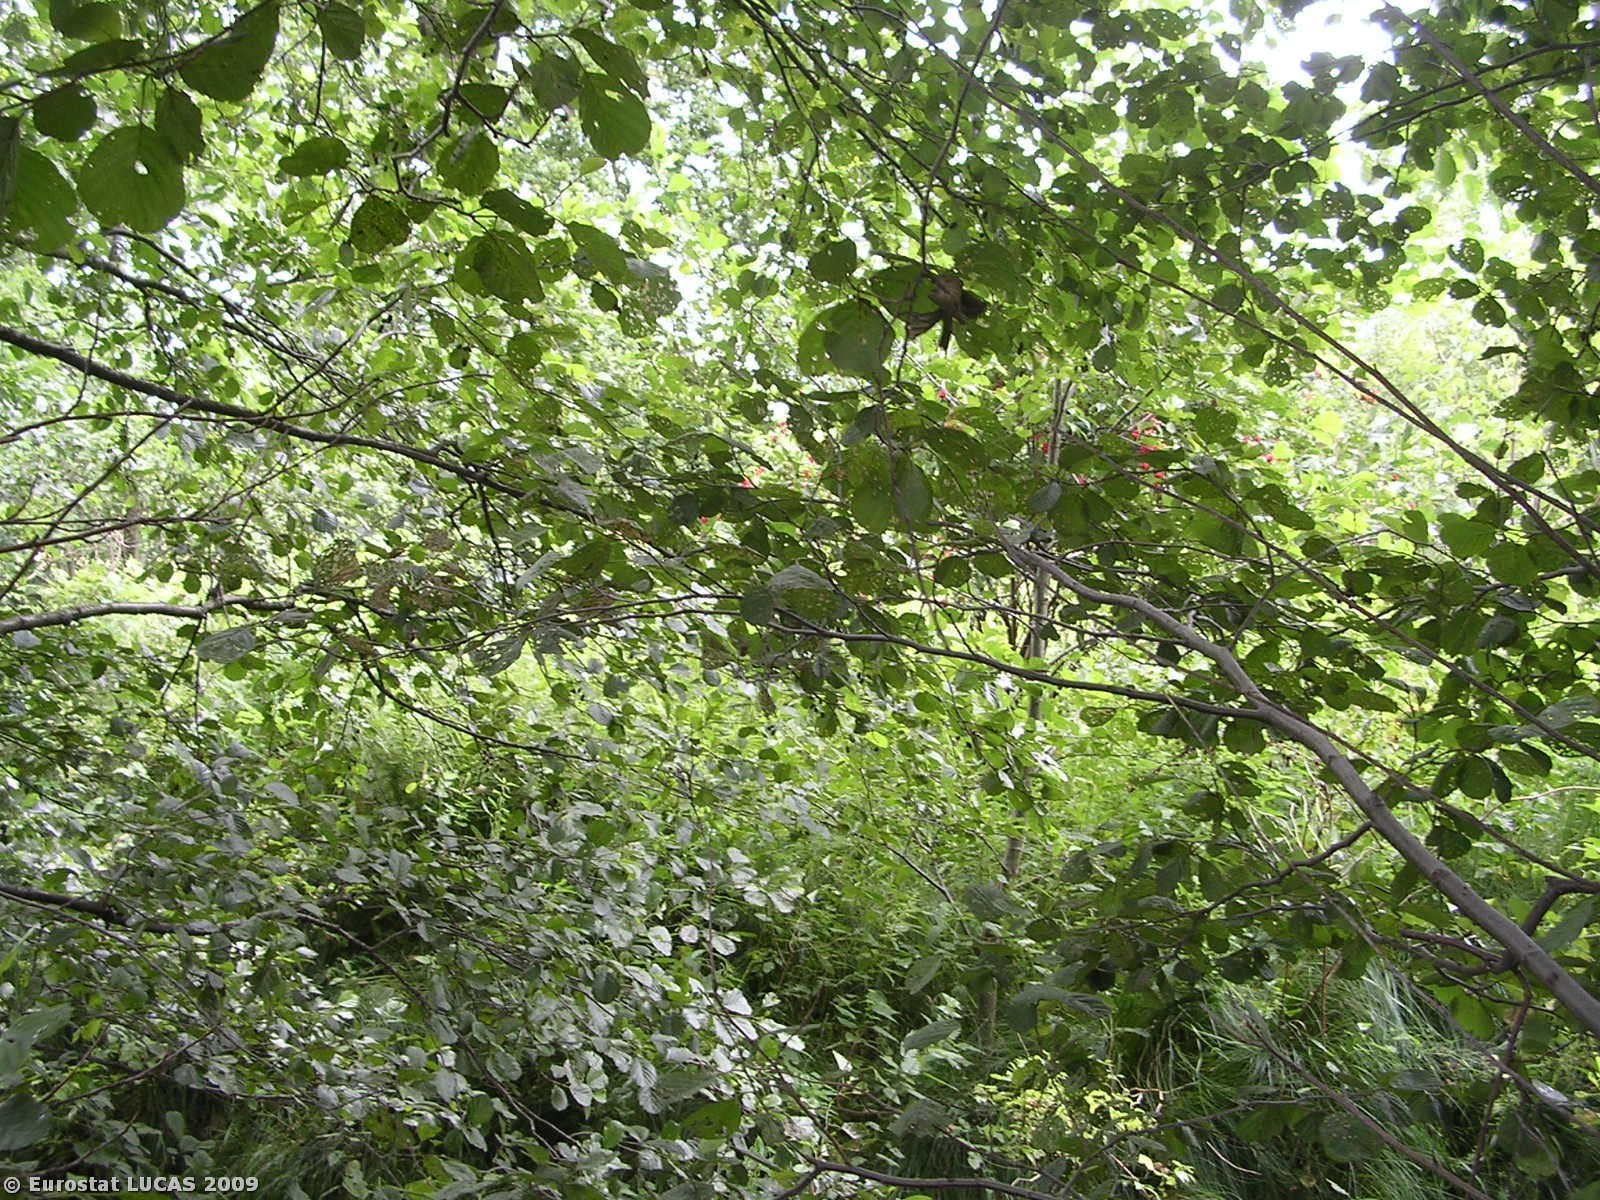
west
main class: Woodland
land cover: Broadleaved woodland
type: floodplain forest
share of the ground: > 75 %
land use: Unused
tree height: > 5 m
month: July
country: CZ
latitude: 50.9665
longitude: 15.2008
